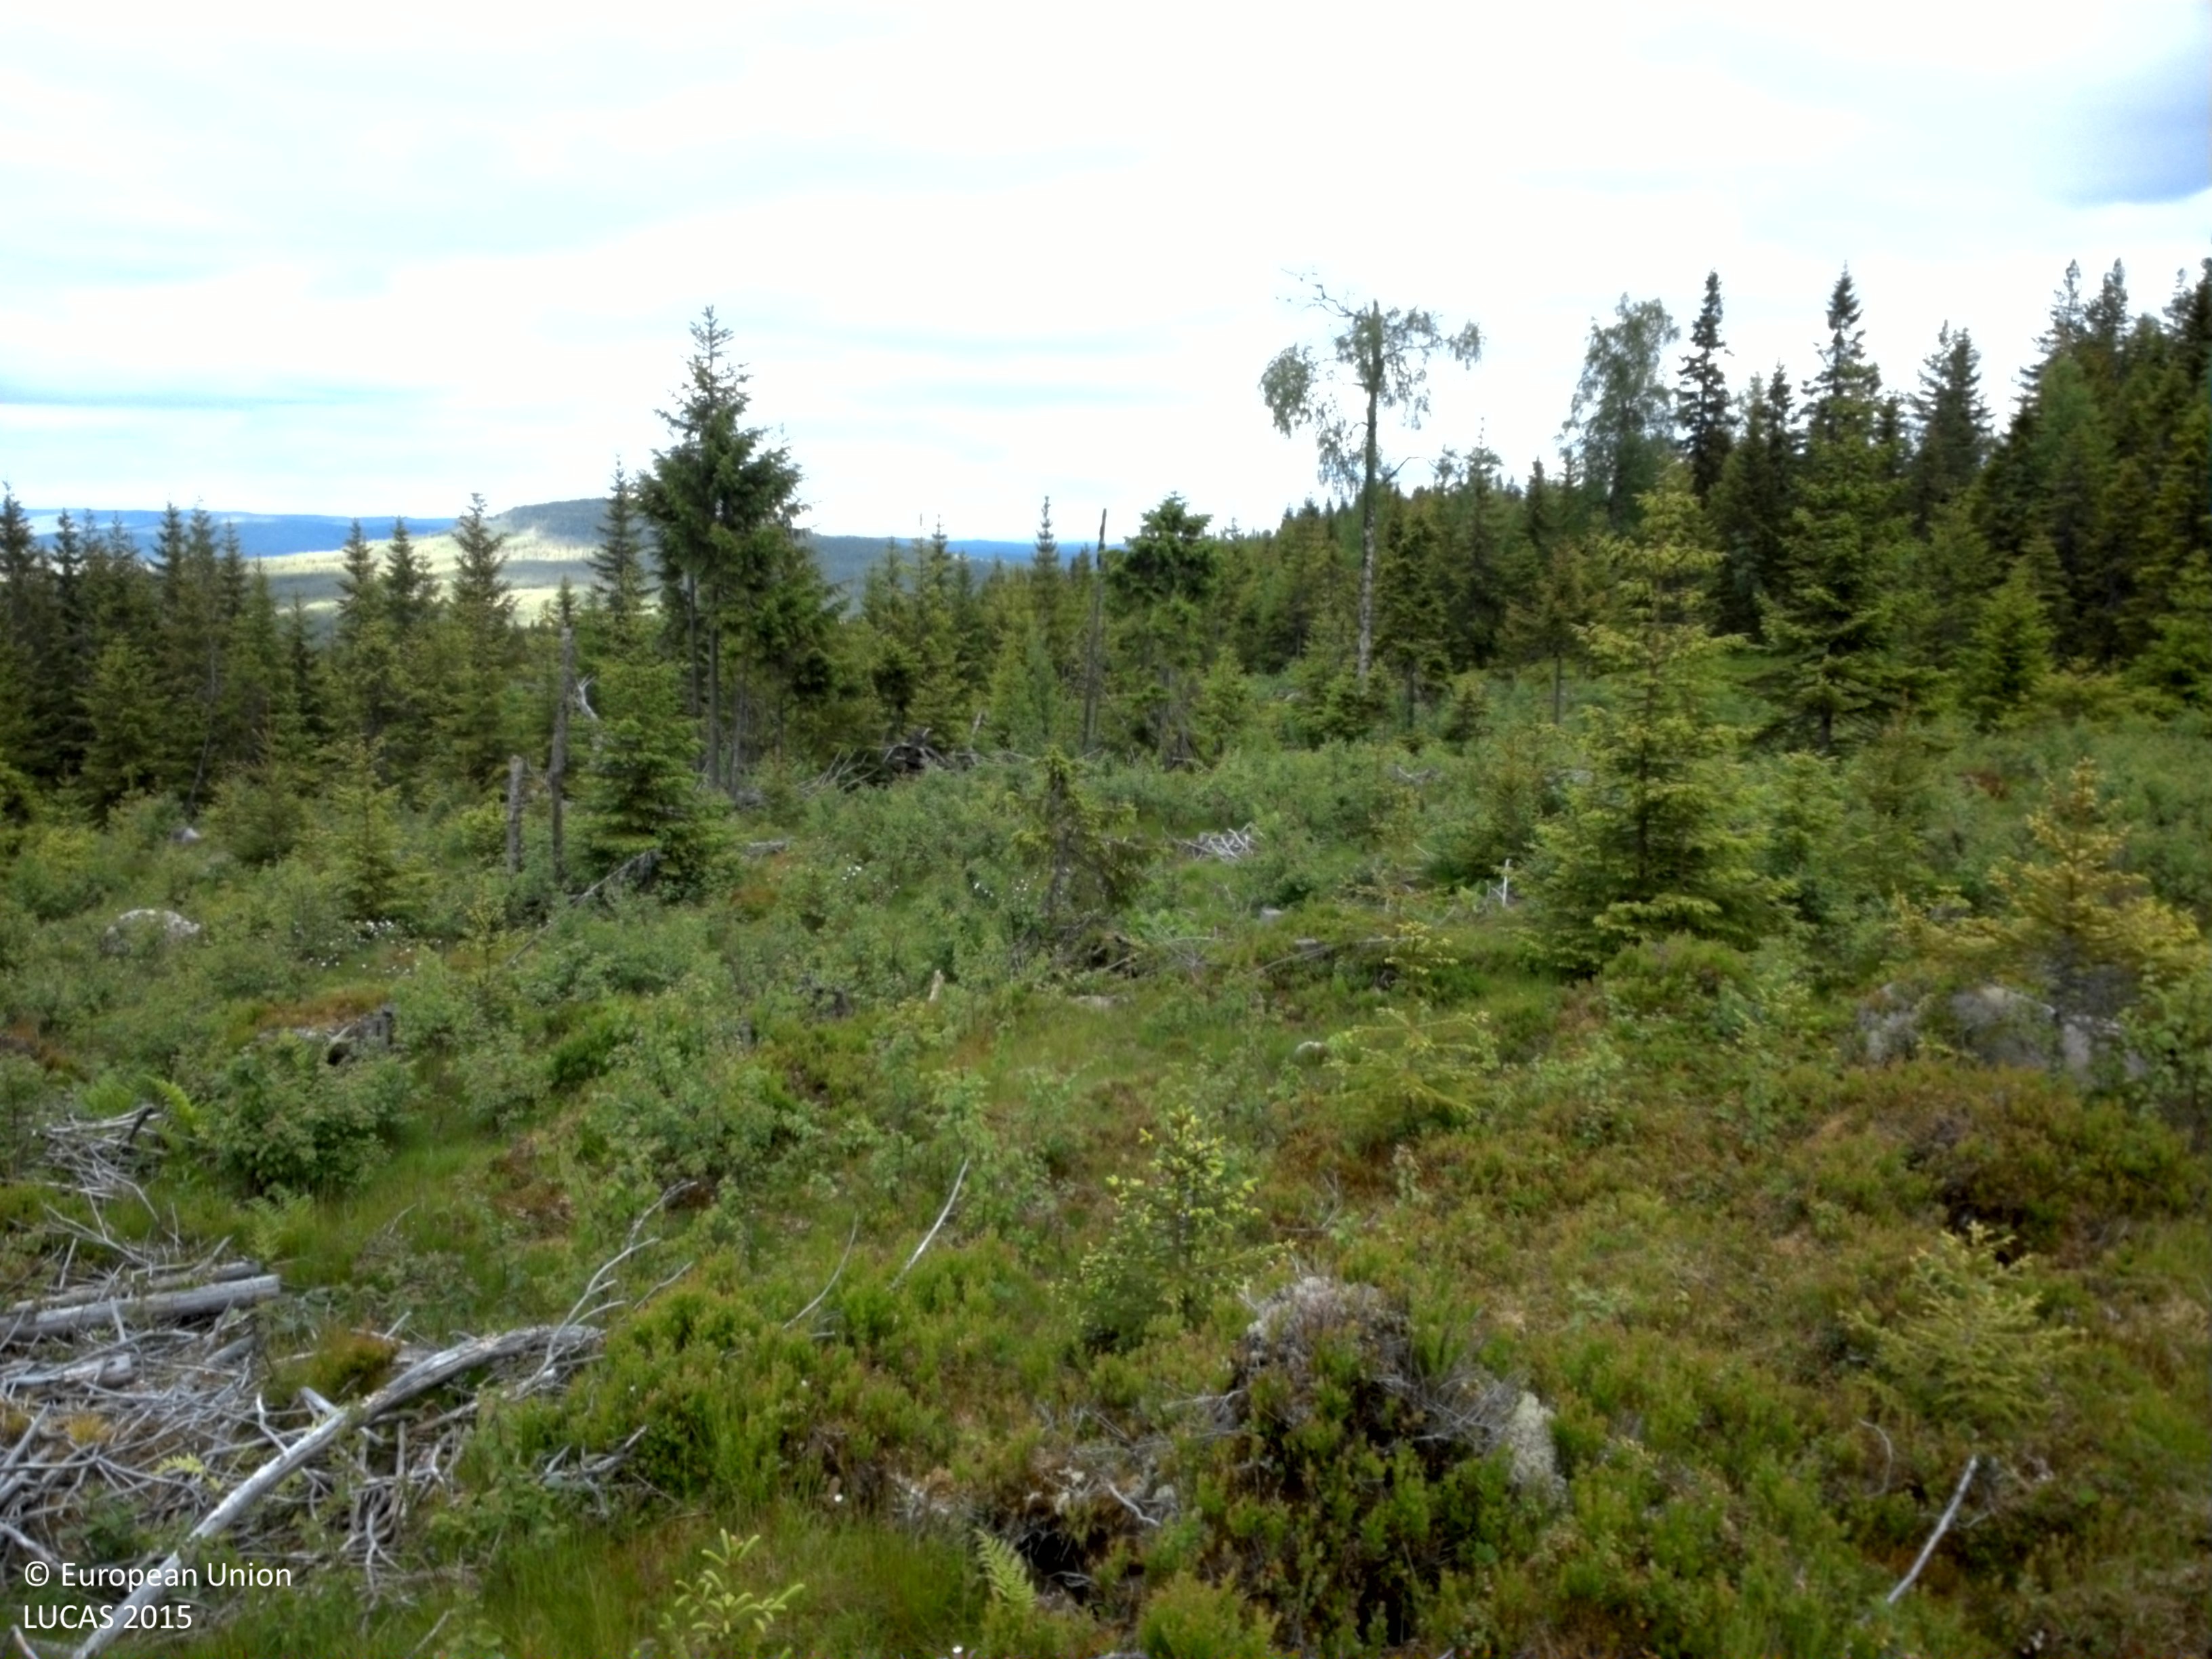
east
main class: Woodland
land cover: Spruce dominated mixed woodland
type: boreal forest
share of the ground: 10 - 25 %
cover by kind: herbaceous plants 65 %, shrubs 15 %, broadleaved forest trees 10 %, coniferous forest trees 5 %, lichens and mosses 5 %
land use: Forestry
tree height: < 5 m
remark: Clear cut
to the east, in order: Spruce dominated mixed woodland; Spruce dominated coniferous woodland
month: June
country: SE
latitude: 60.6628
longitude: 12.4985
